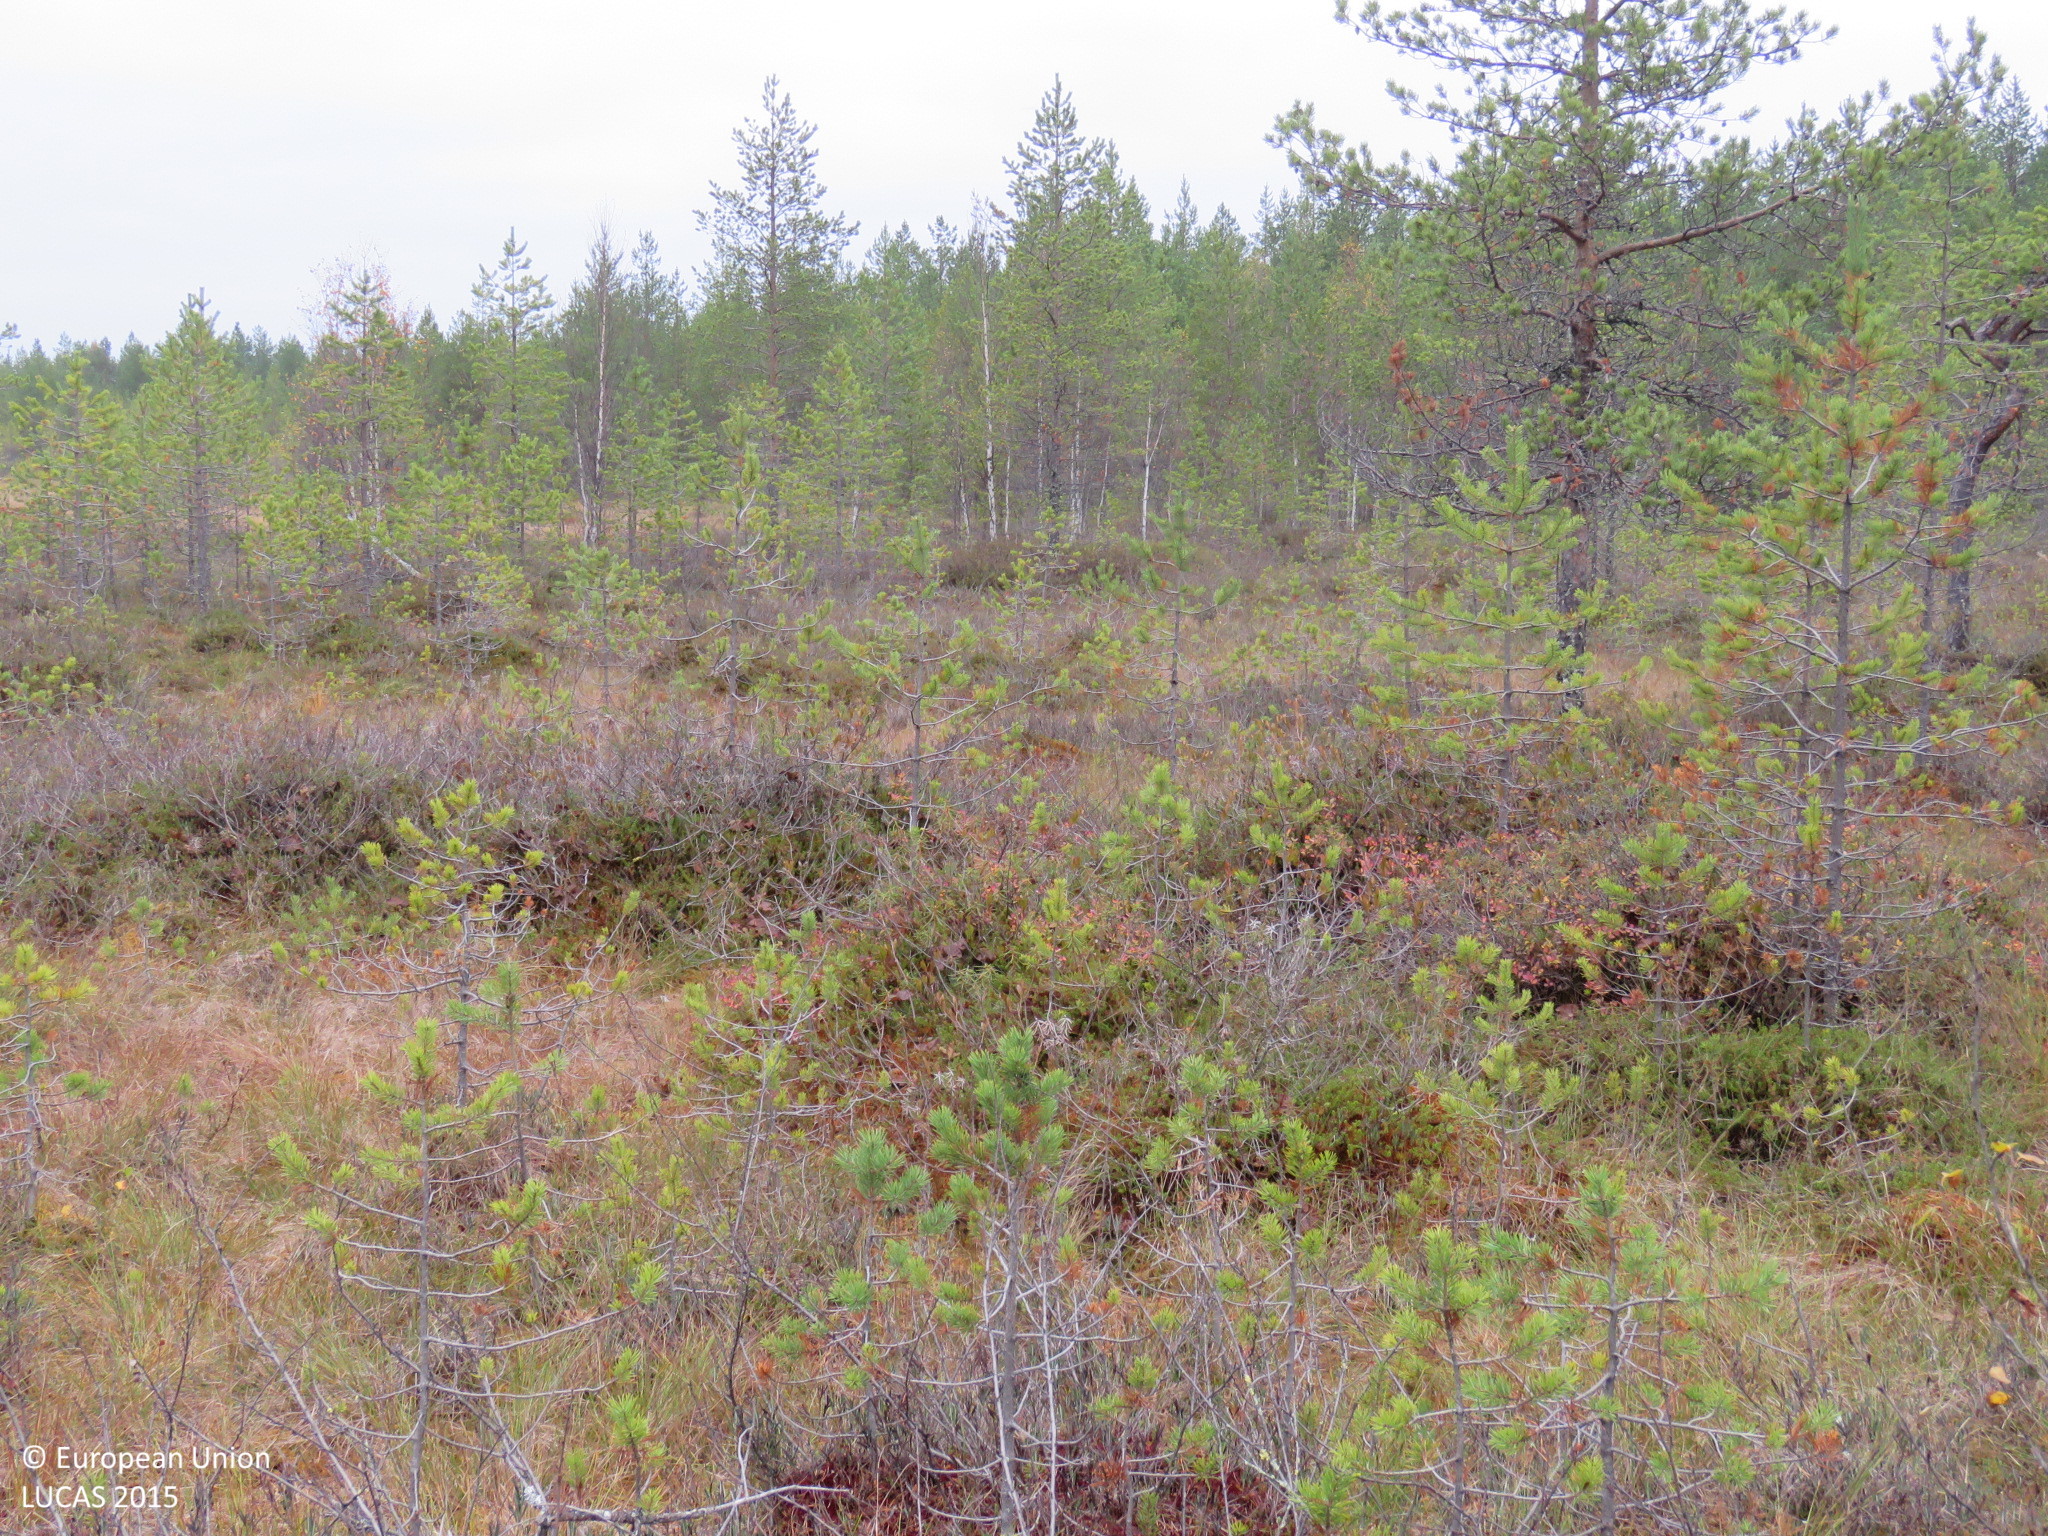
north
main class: Woodland
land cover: Pine dominated coniferous woodland
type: mire and swamp forests
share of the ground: 25 - 50 %
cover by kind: coniferous forest trees 45 %, shrubs 25 %, herbaceous plants 20 %, lichens and mosses 10 %
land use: Forestry
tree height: < 5 m
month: September
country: FI
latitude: 65.2751
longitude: 26.8043
